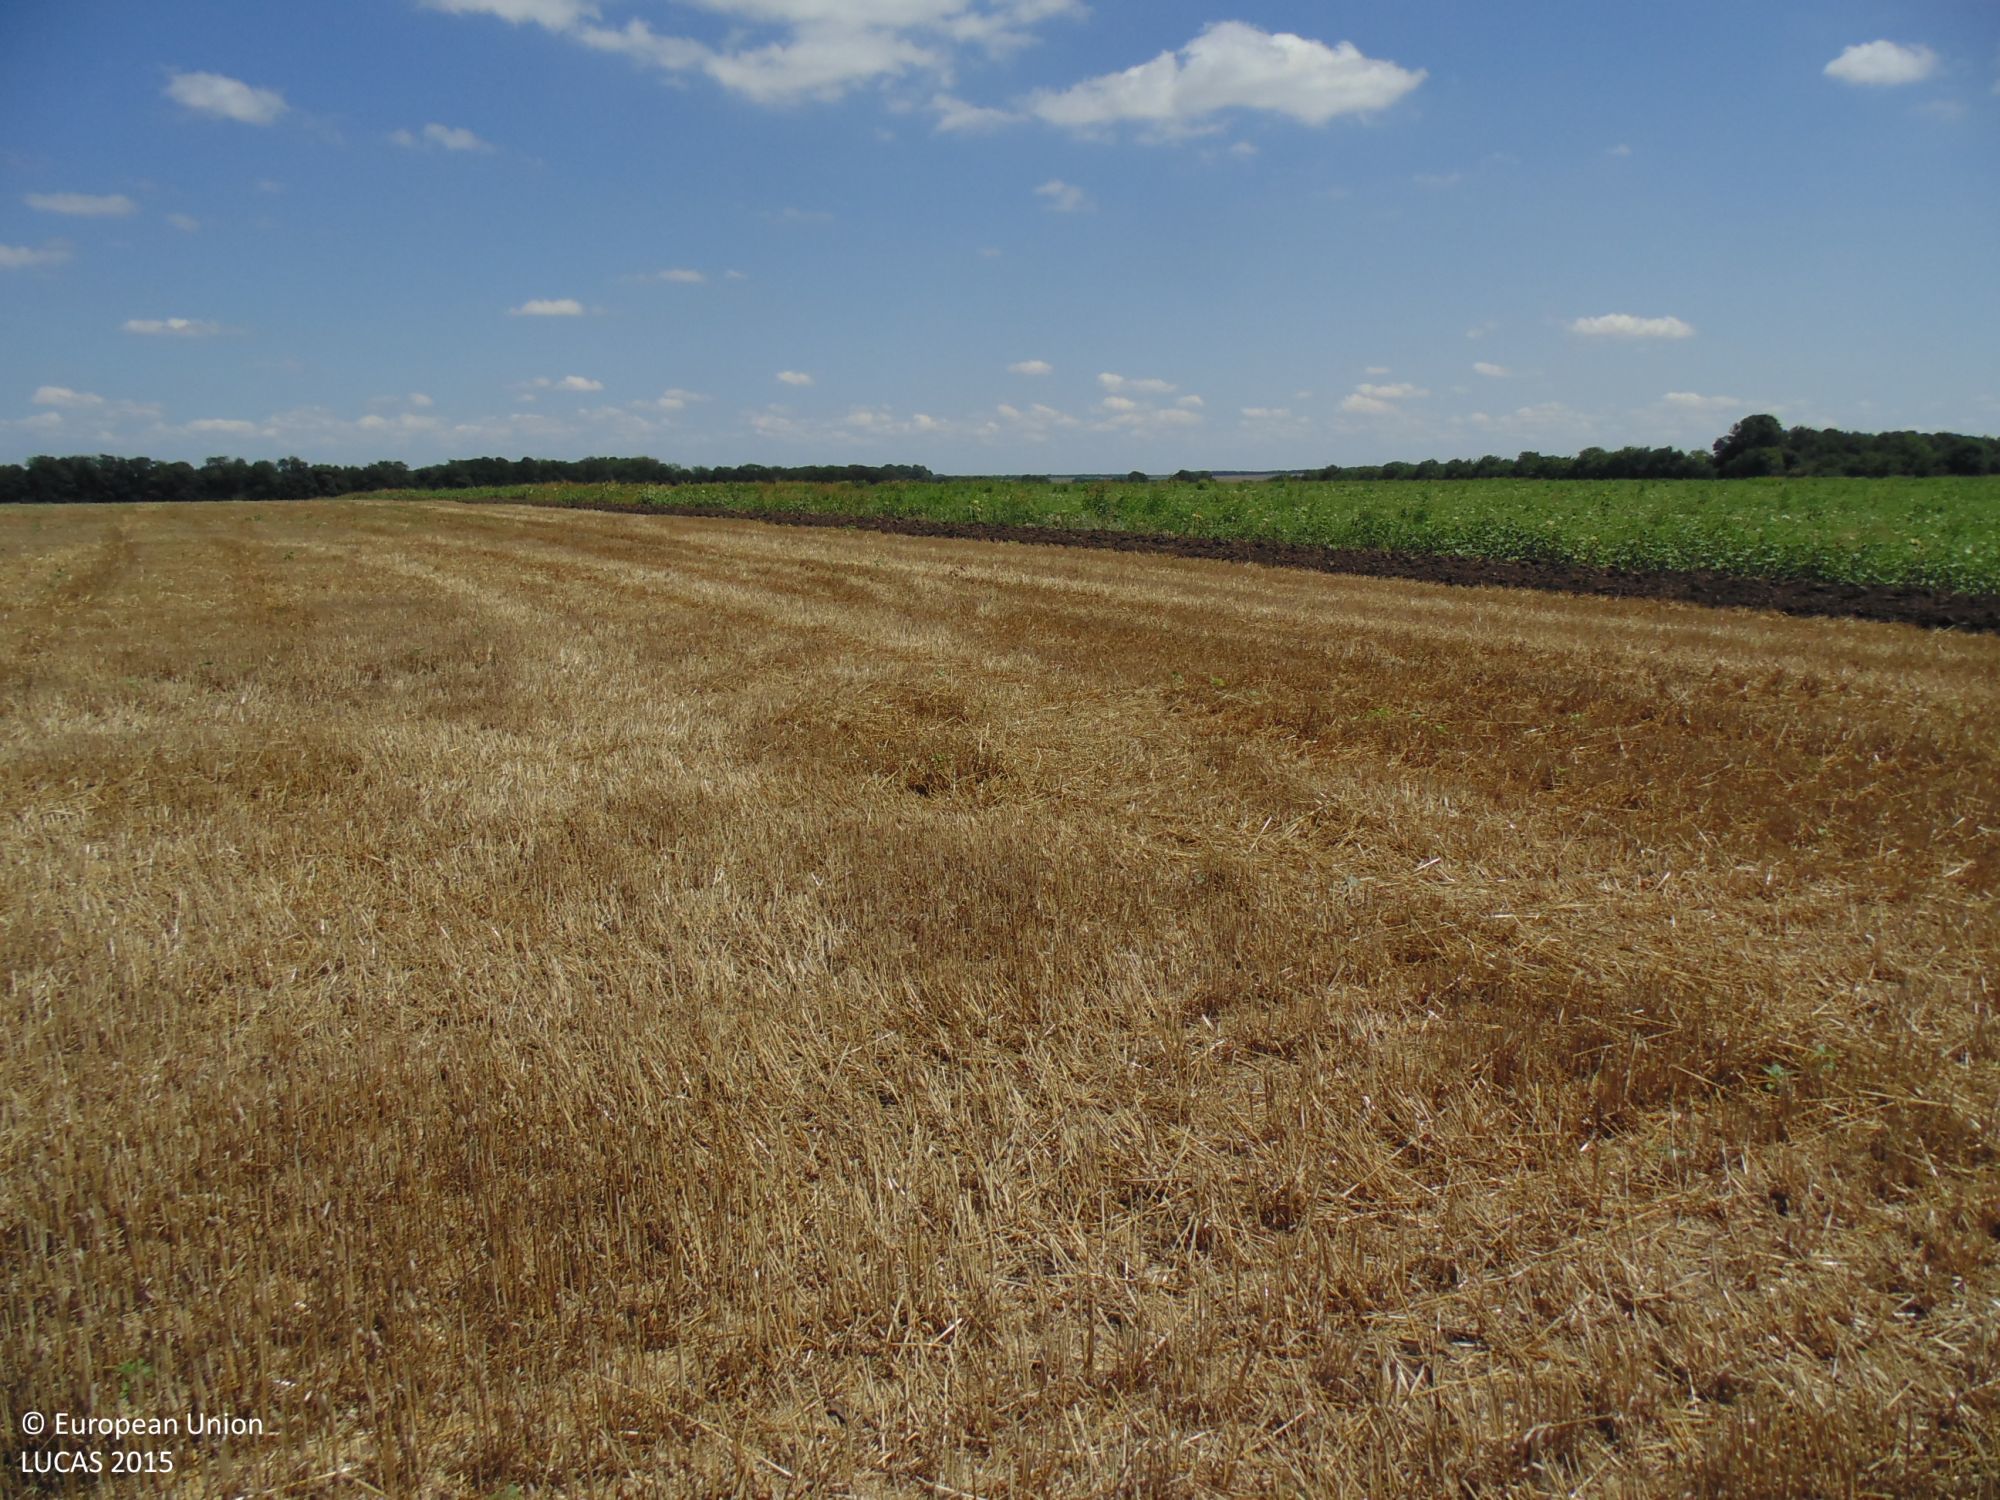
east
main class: Cropland
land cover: Common wheat
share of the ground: > 75 %
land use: Agriculture (excluding fallow land and kitchen gardens)
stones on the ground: < 10 %
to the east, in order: Common wheat; Grass margins; Other fresh vegetables
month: August
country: BG
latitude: 43.5873
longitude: 28.1215
